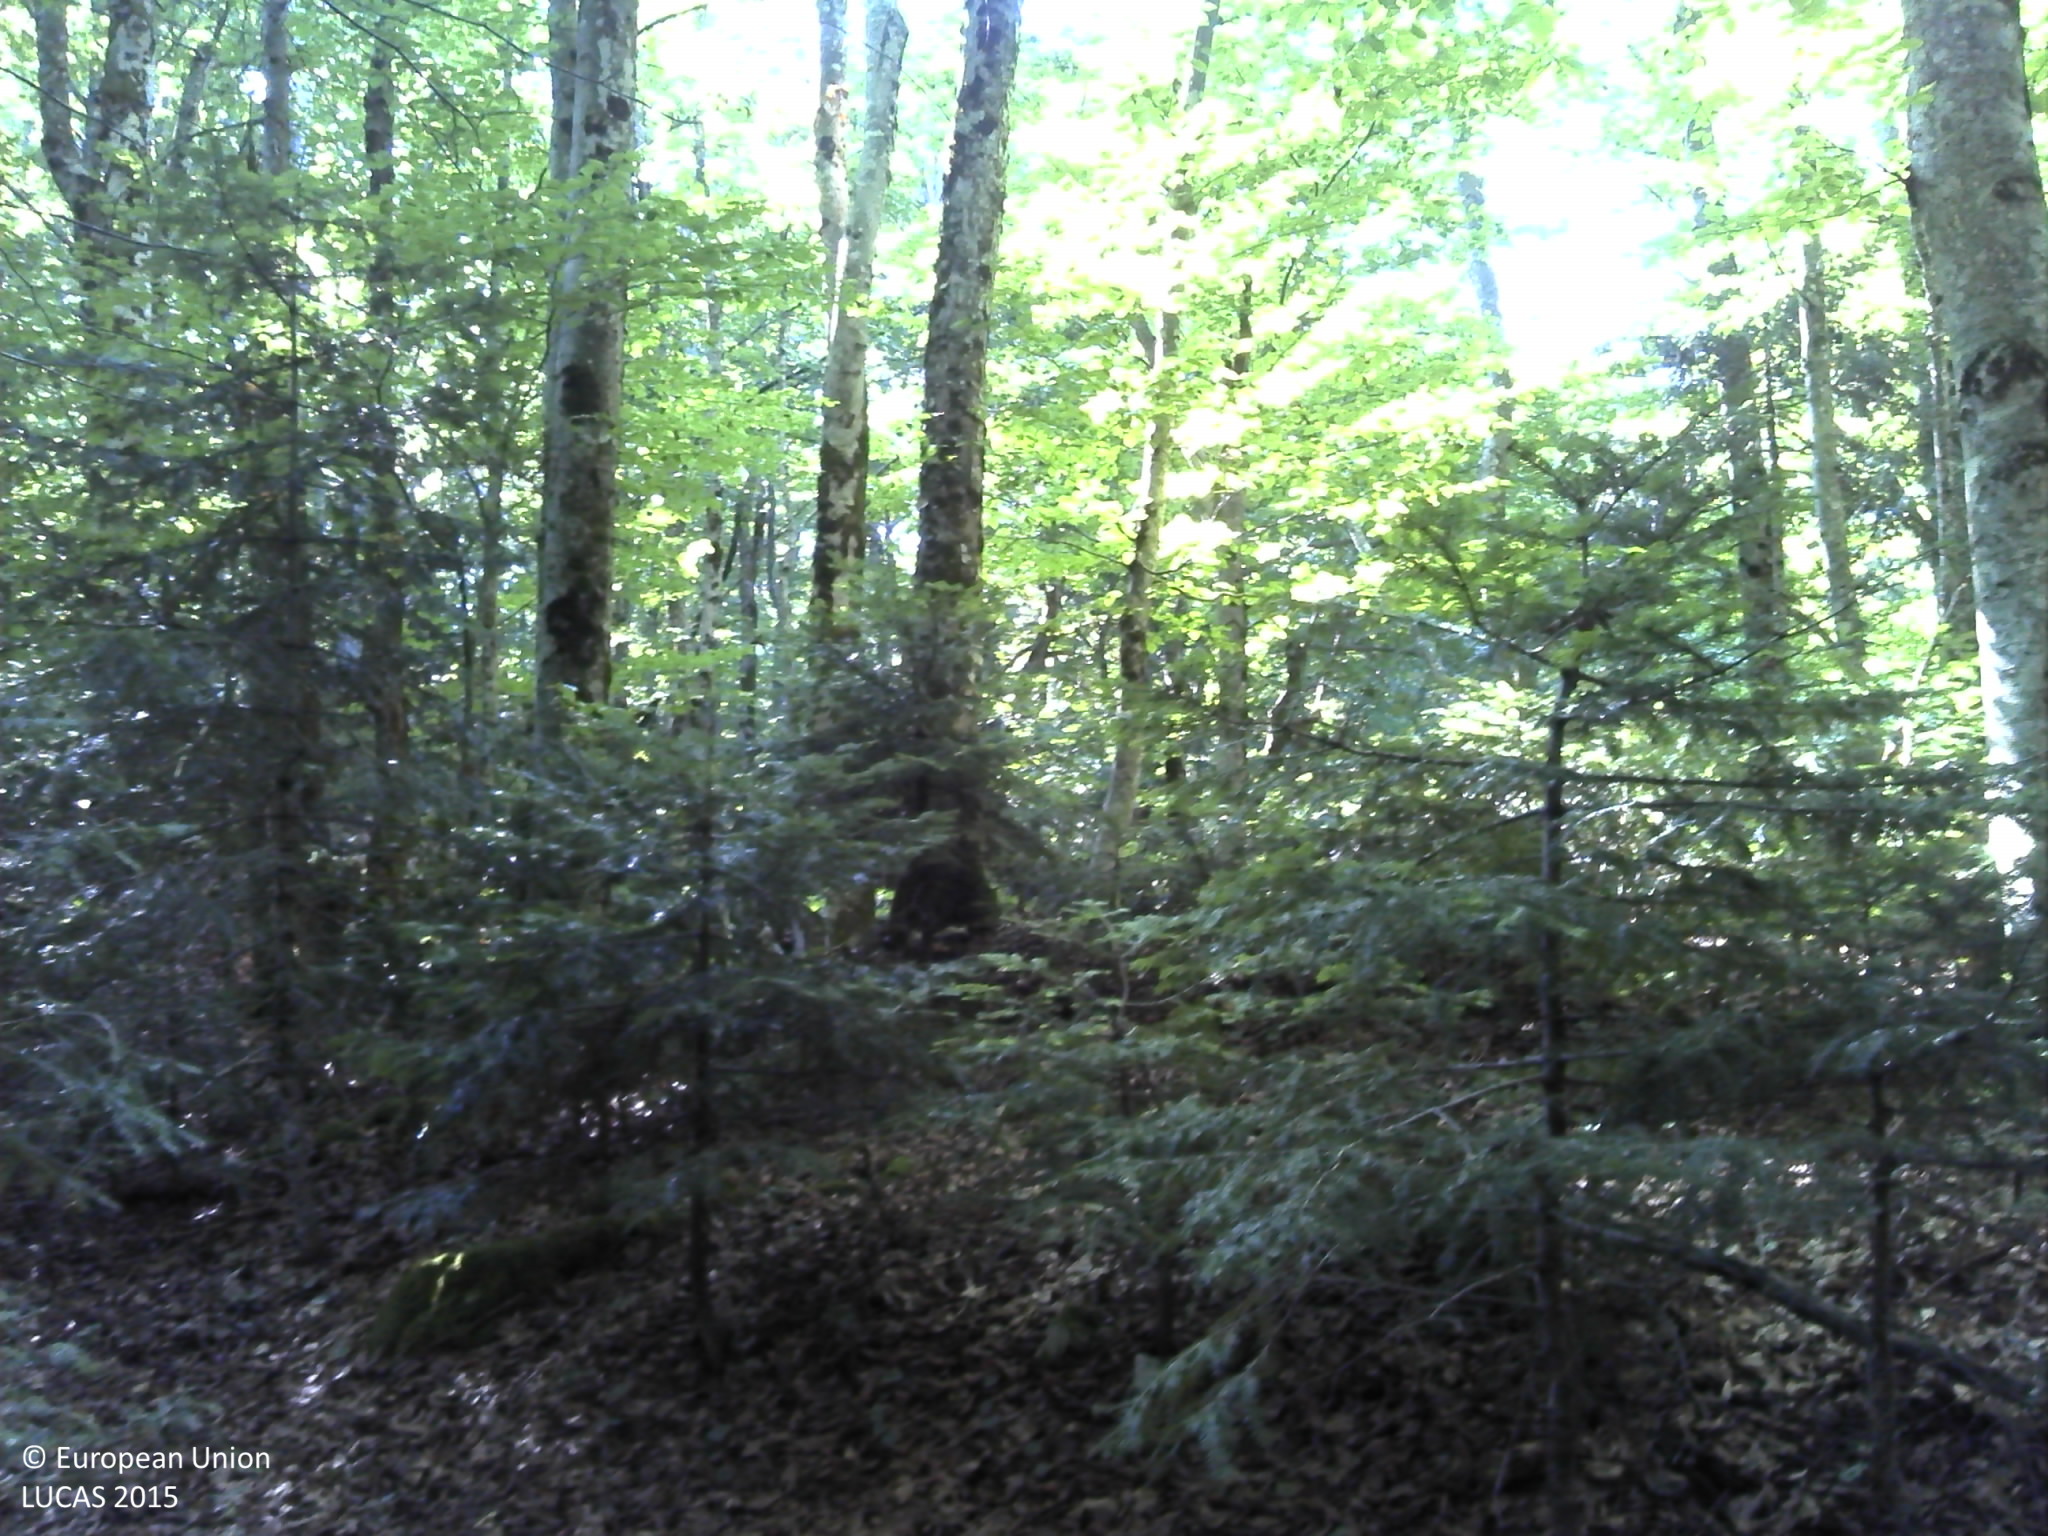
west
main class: Woodland
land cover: Broadleaved woodland
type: beech forest
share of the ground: > 75 %
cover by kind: broadleaved forest trees 70 %, coniferous forest trees 10 %, shrubs 10 %, consolidated bare surface 10 %
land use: Forestry
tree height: > 5 m
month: August
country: HR
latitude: 44.9232
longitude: 15.5817
